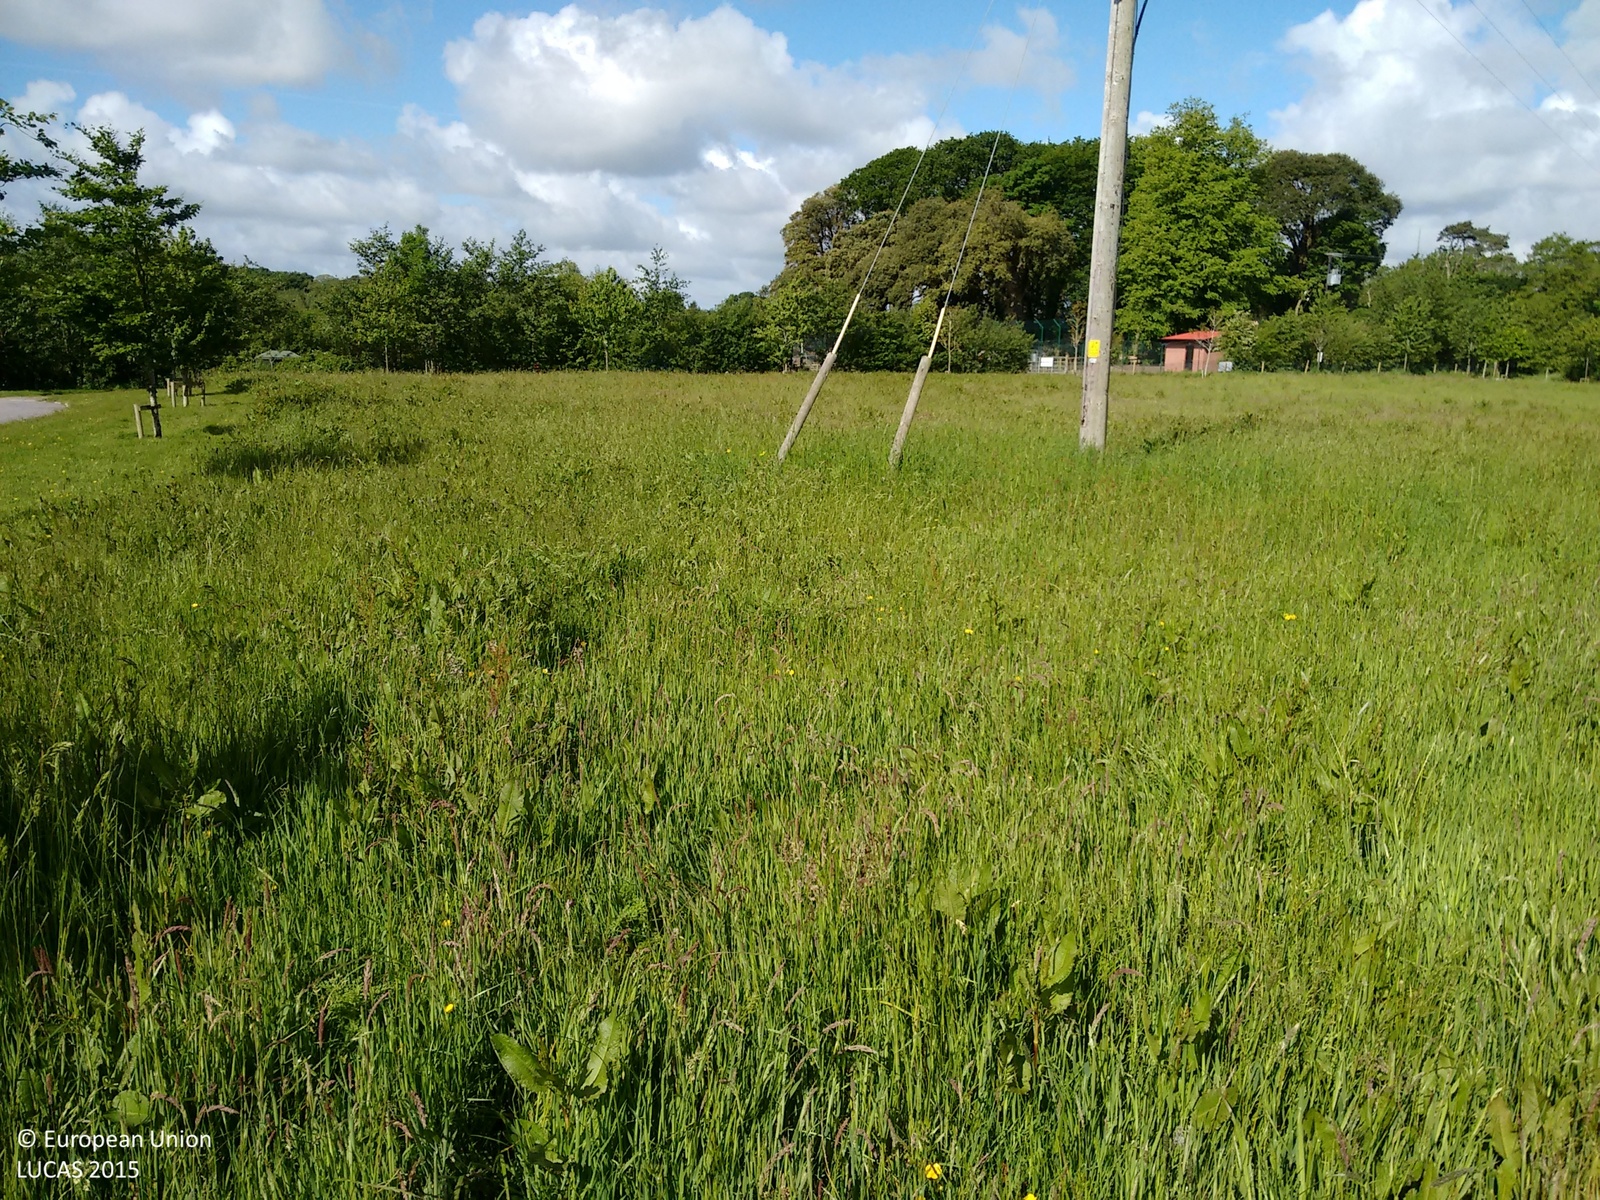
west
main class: Grassland
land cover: Grassland without tree/shrub cover
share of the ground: > 75 %
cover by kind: herbaceous plants 70 %, consolidated bare surface 30 %
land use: Agriculture (excluding fallow land and kitchen gardens)
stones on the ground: < 10 %
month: June
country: IE
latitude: 51.8954
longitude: -8.3083
